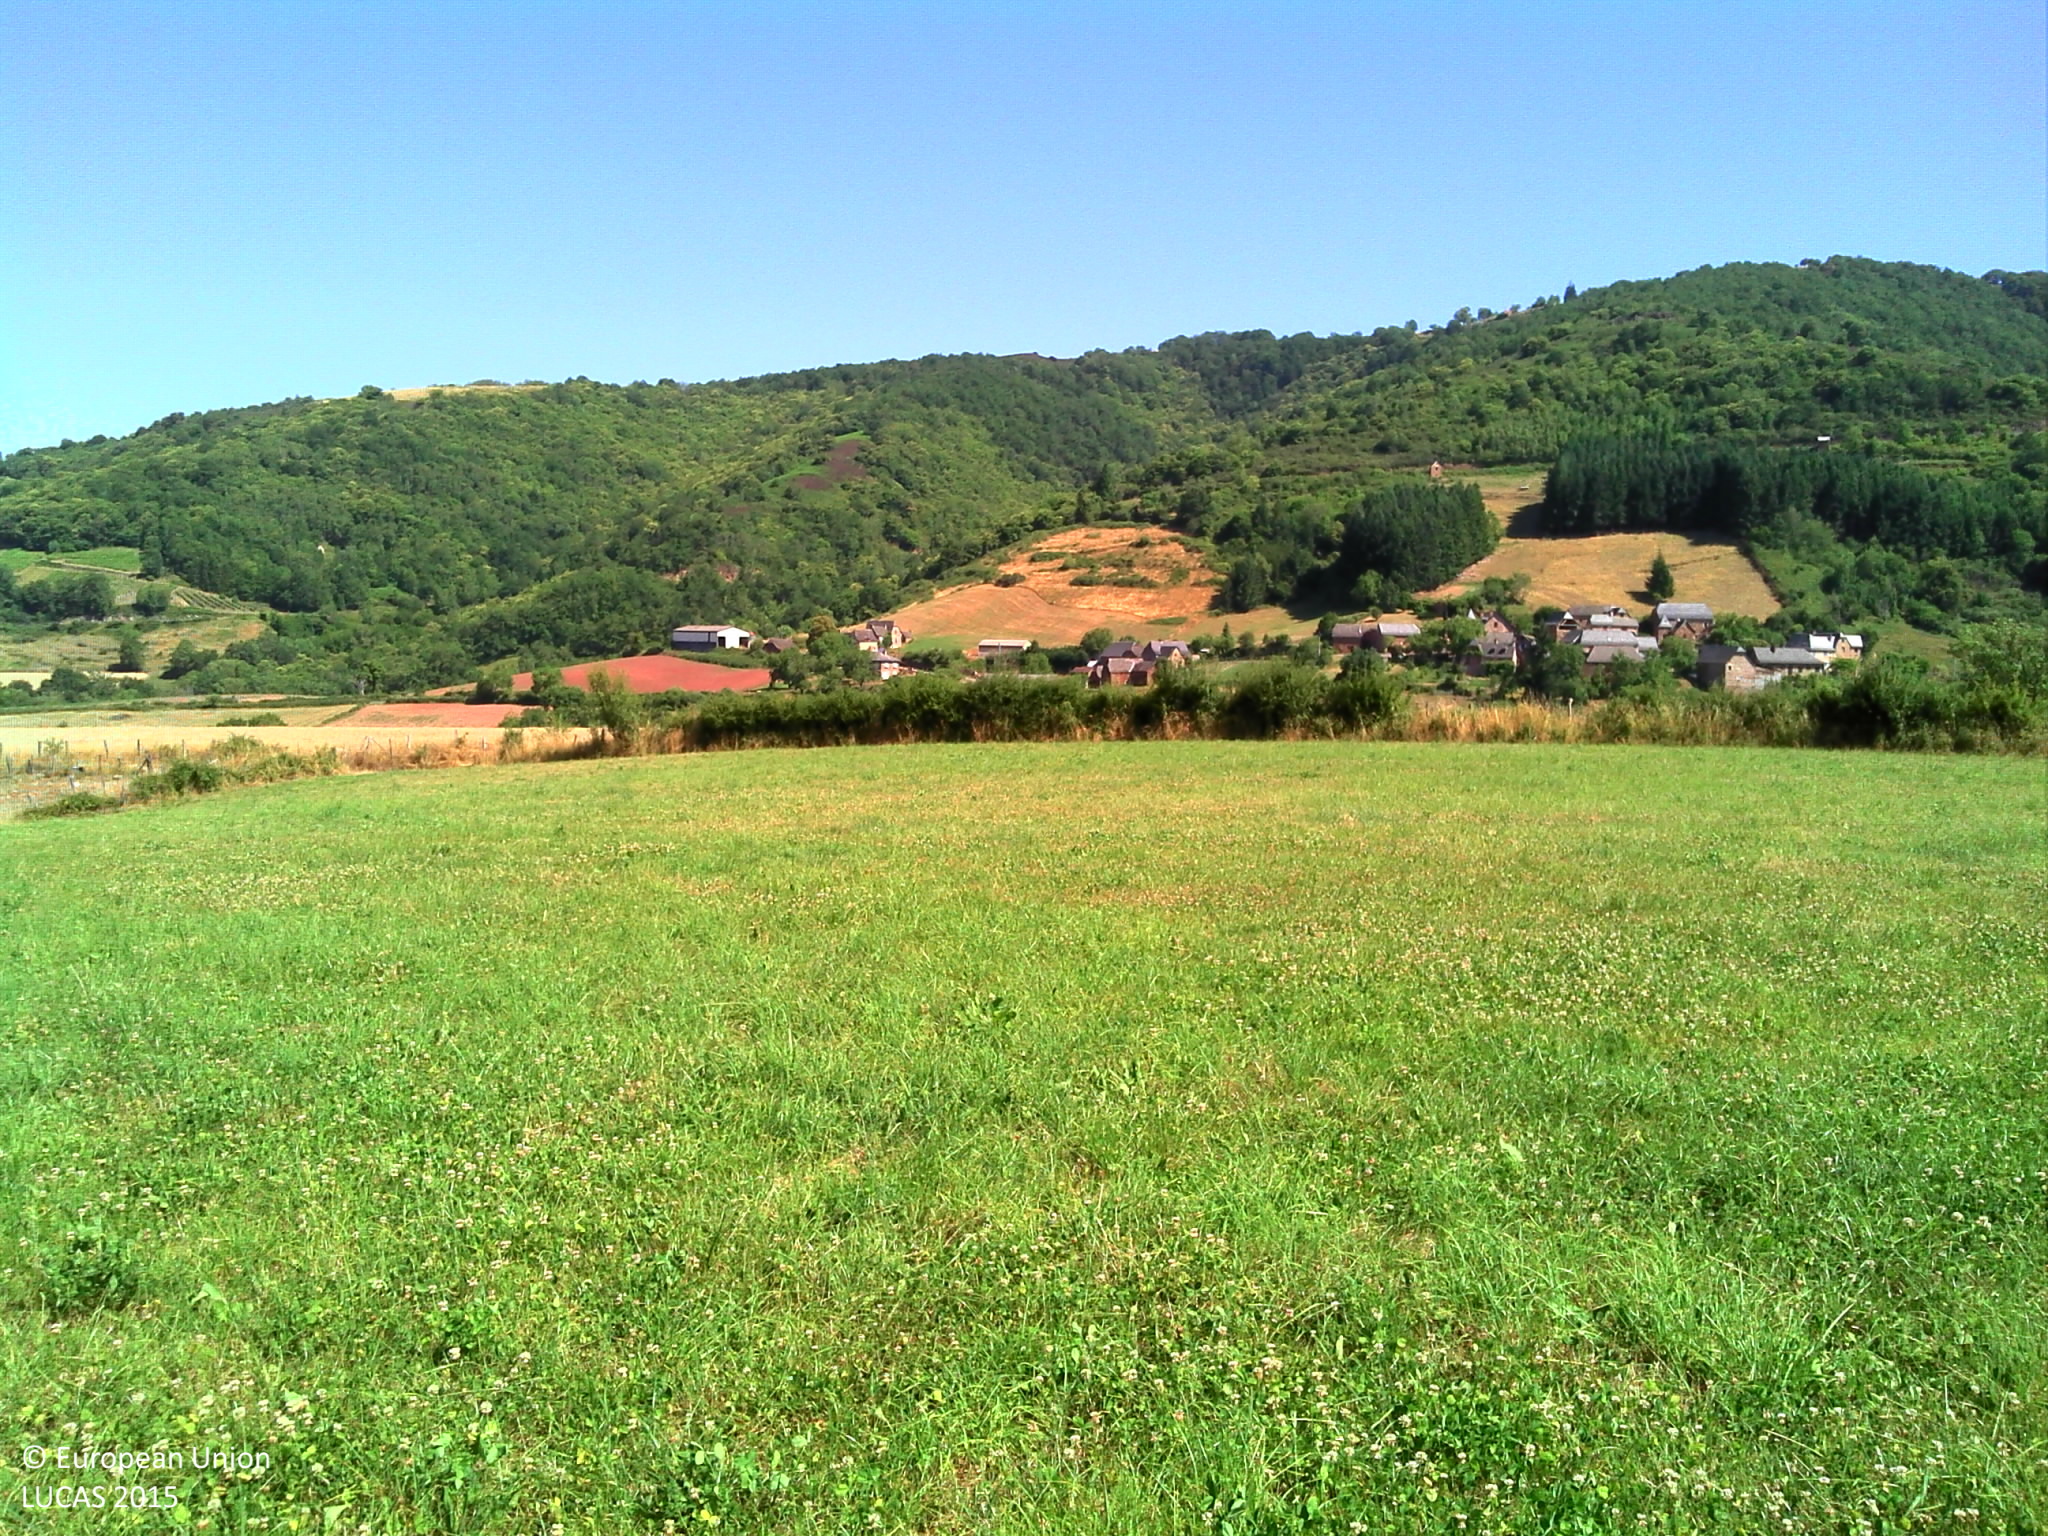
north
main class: Grassland
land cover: Grassland without tree/shrub cover
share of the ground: > 75 %
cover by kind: herbaceous plants 100 %
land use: Agriculture (excluding fallow land and kitchen gardens)
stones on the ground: < 10 %
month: June
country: FR
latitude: 44.5451
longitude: 2.4375
